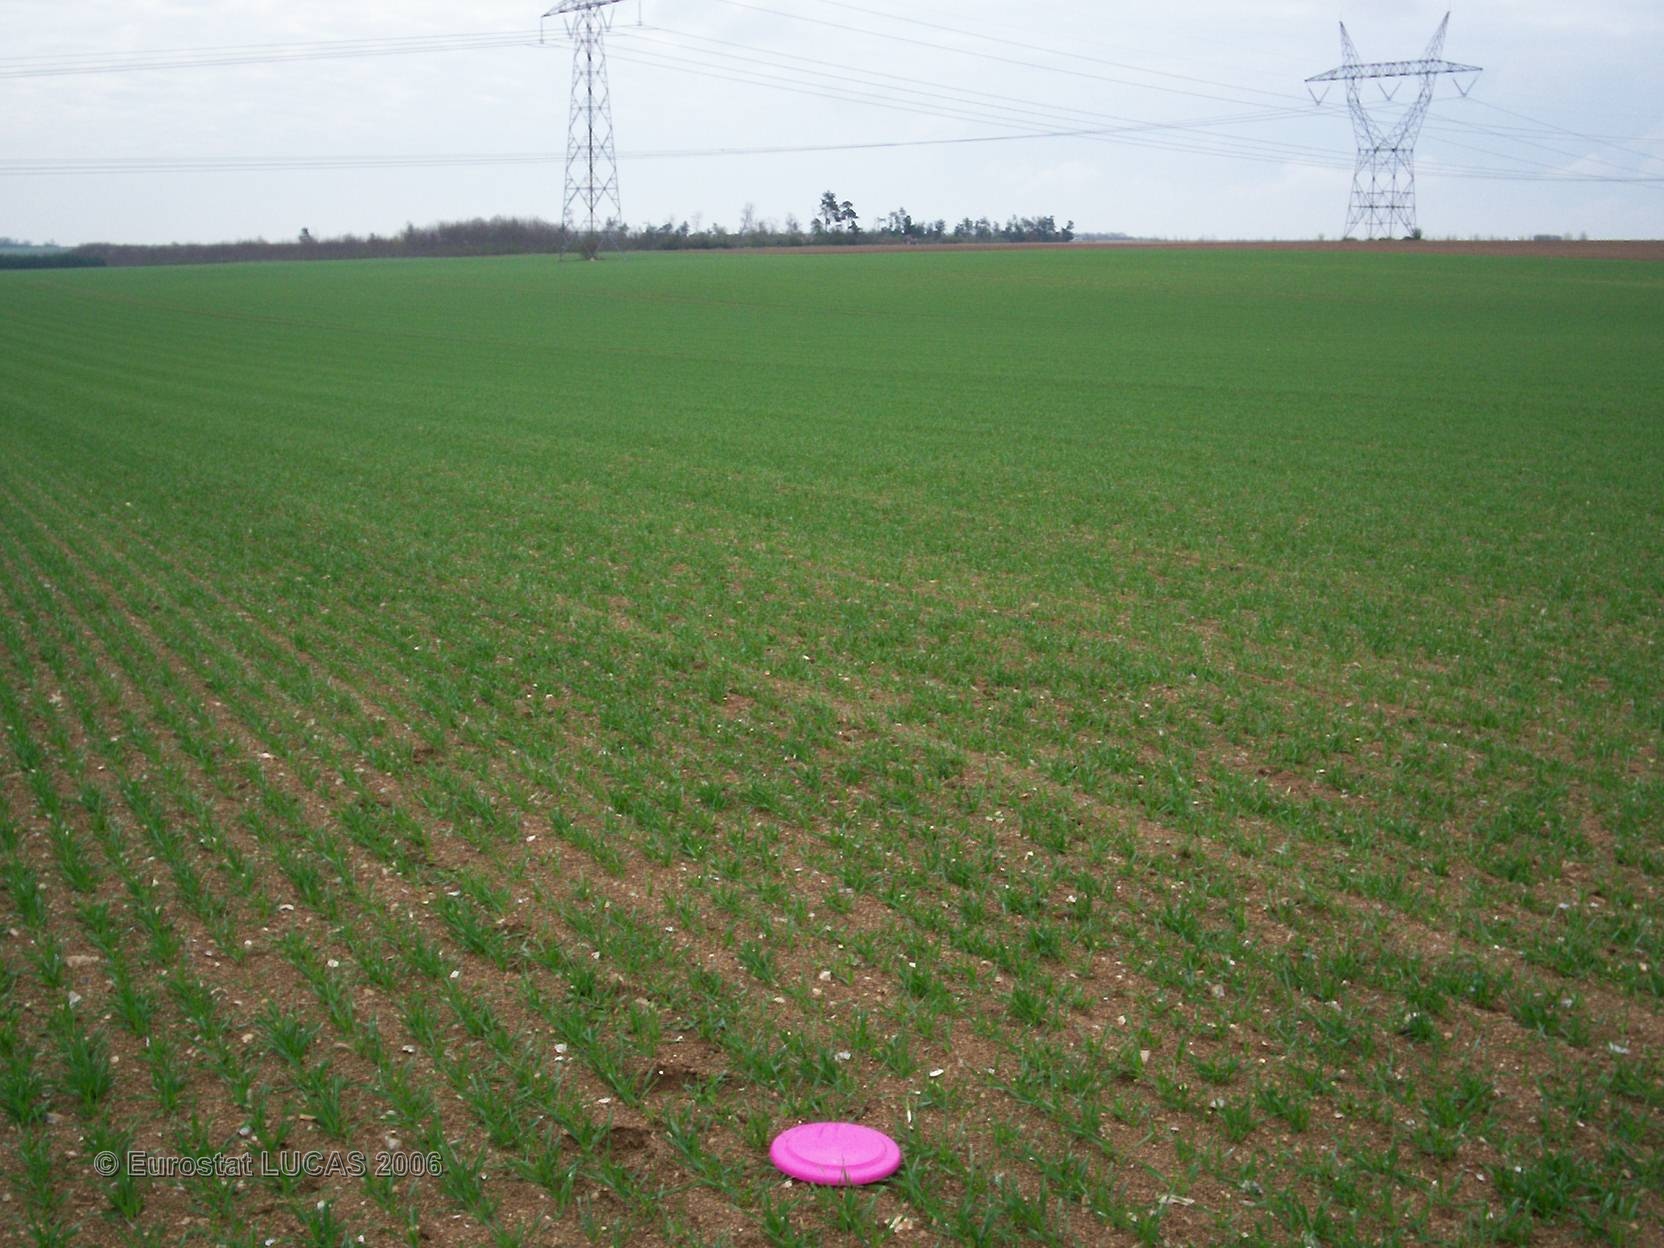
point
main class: Cropland
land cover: Barley
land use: Agriculture (excluding fallow land and kitchen gardens)
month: April
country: FR
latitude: 48.4559
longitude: 3.9785
